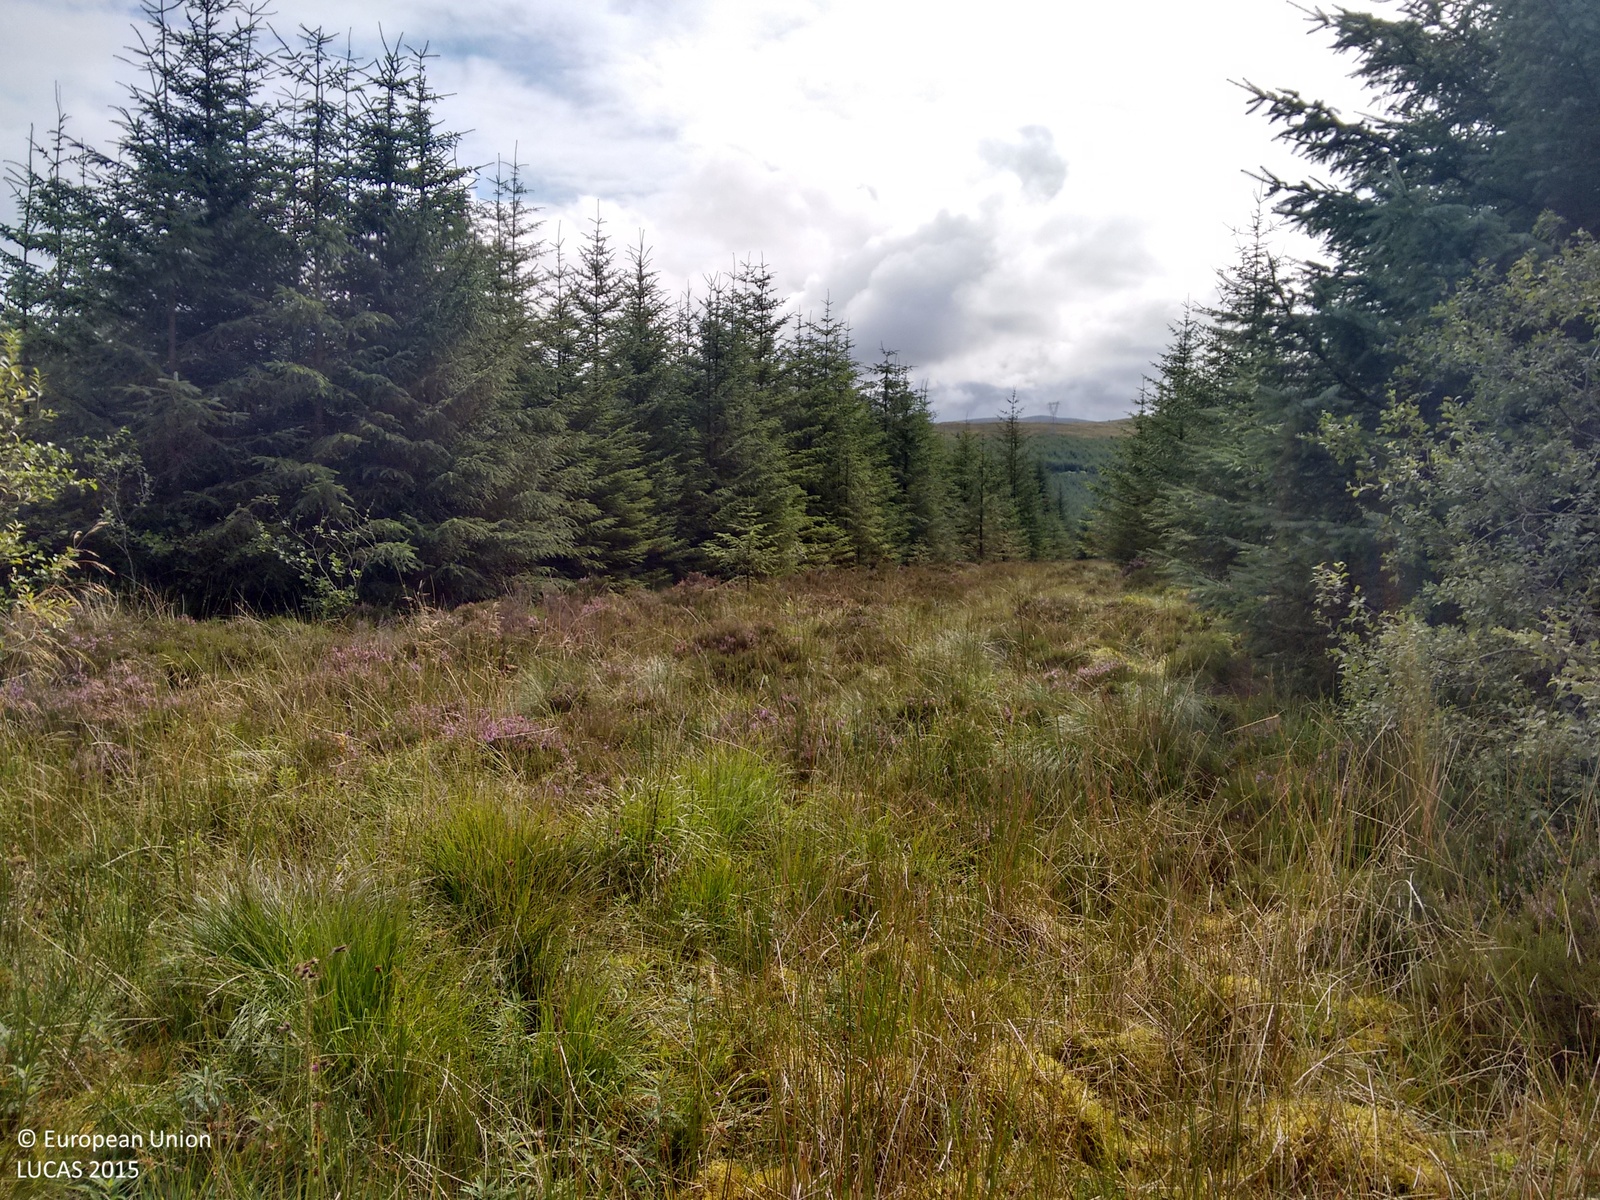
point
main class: Woodland
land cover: Spruce dominated coniferous woodland
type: exotic forest
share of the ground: > 75 %
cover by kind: coniferous forest trees 100 %
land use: Forestry
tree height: > 5 m
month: September
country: GB
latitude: 55.2416
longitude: -4.5560
